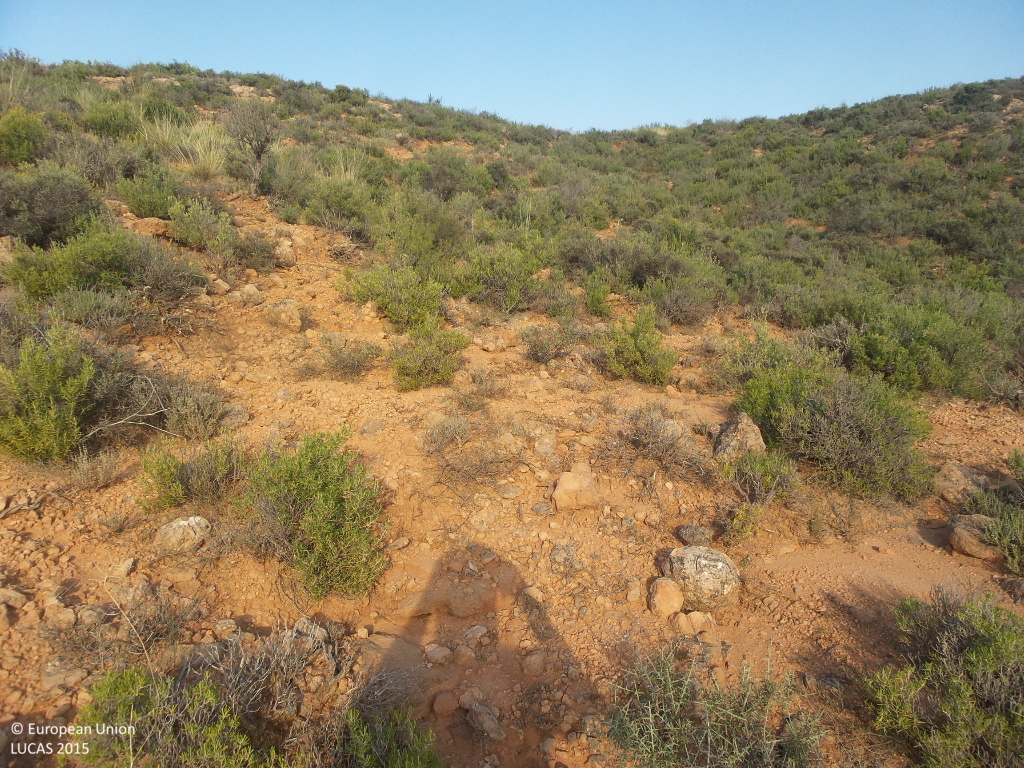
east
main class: Shrubland
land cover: Shrubland without tree cover
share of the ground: 25 - 50 %
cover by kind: shrubs 40 %, unconsolidated bare surface 30 %, consolidated bare surface 25 %, herbaceous plants 5 %
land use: Semi-natural and natural areas not in use
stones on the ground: < 10 %
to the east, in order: Shrubland without tree cover; Other bare soil; Shrubland without tree cover
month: July
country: ES
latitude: 41.2427
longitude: -2.1644
